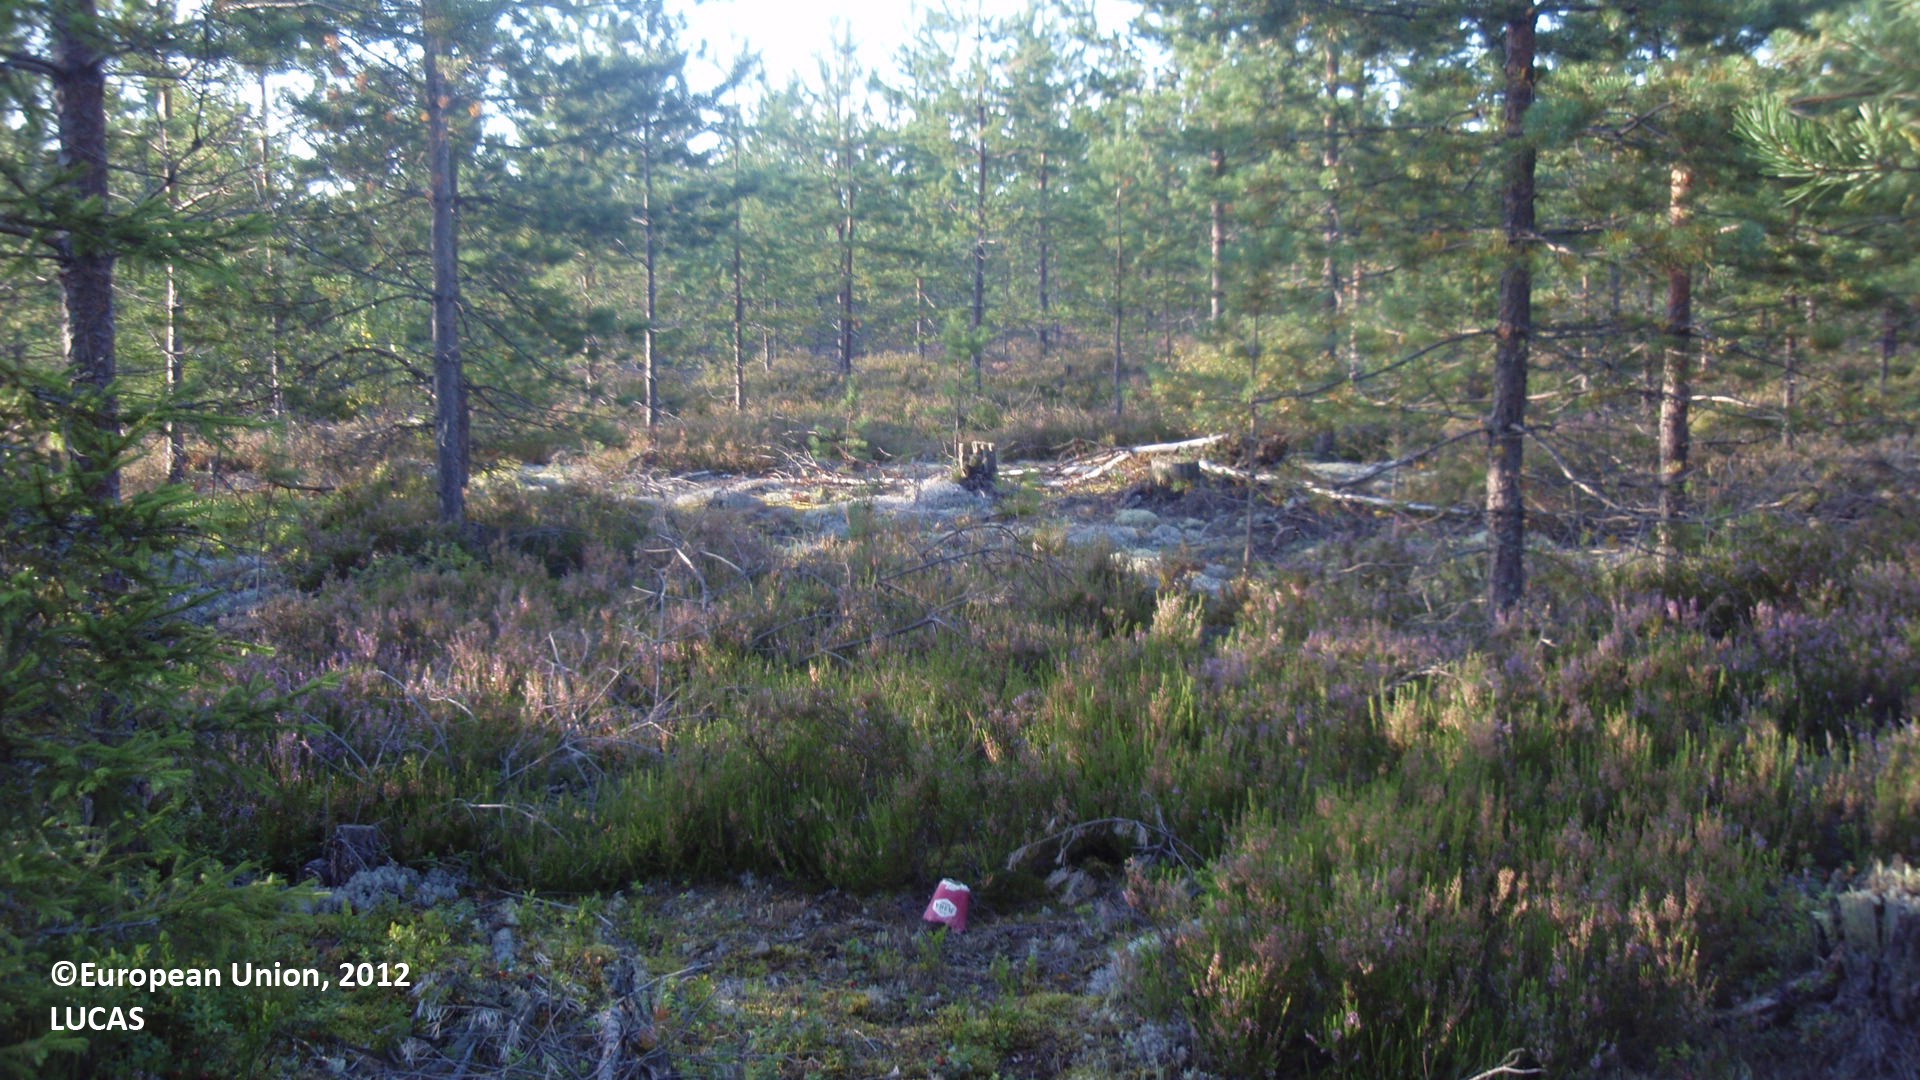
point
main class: Woodland
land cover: Pine dominated coniferous woodland
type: boreal forest
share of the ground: 25 - 50 %
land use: Forestry
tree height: > 5 m
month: August
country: FI
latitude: 60.8113
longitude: 27.5187
